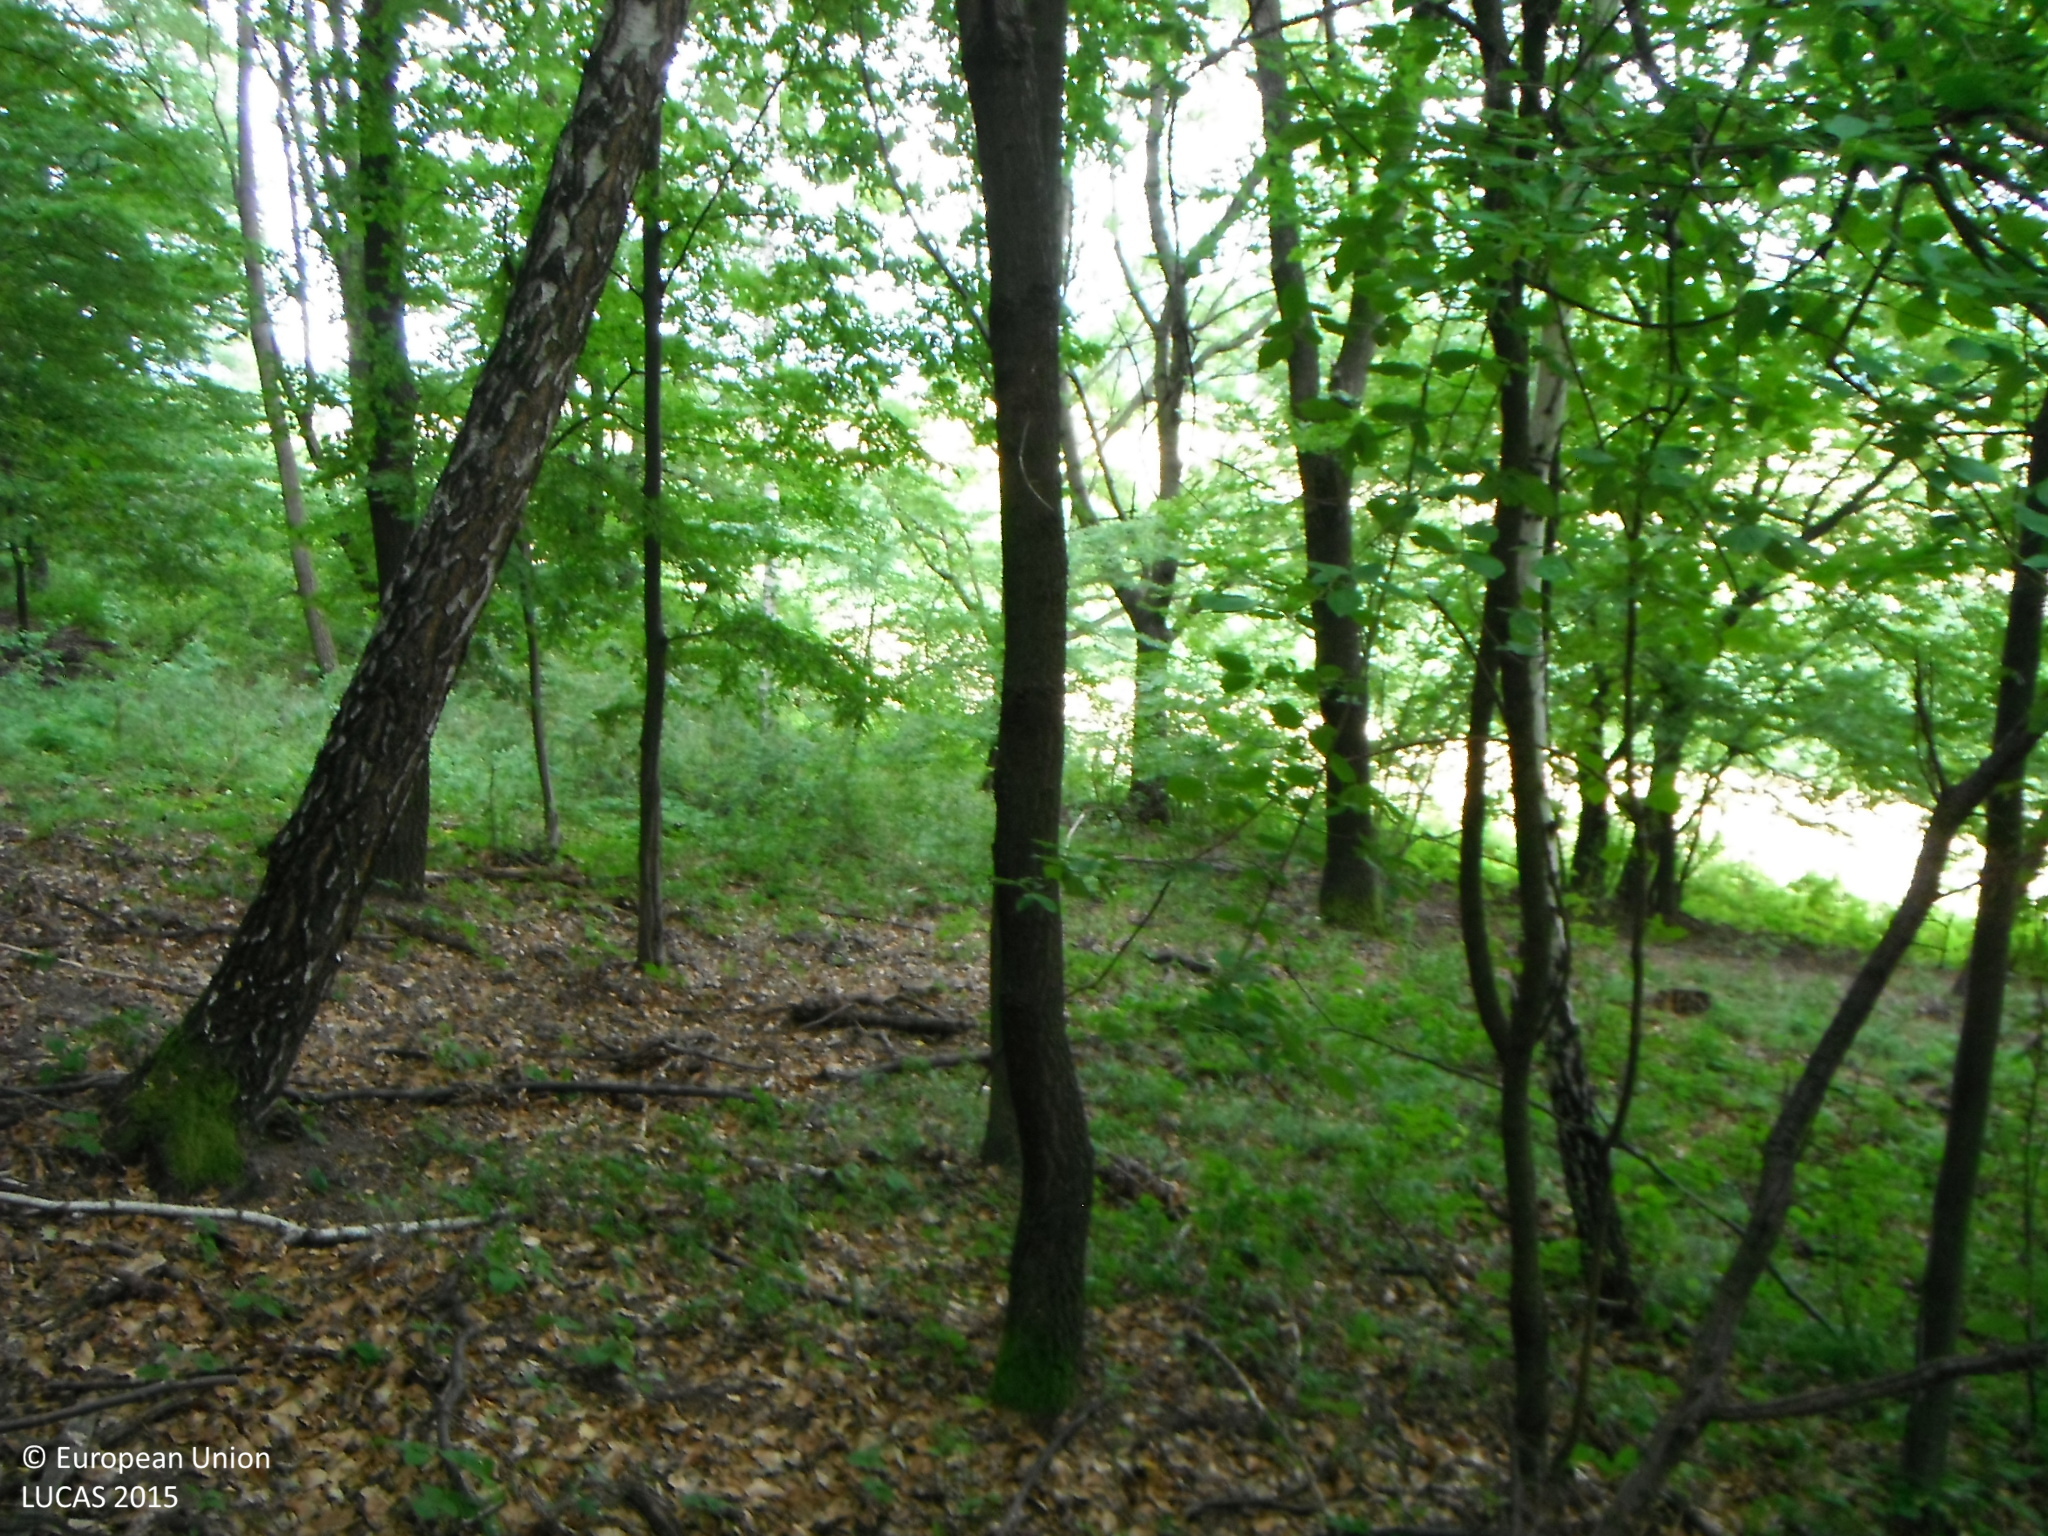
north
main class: Woodland
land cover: Broadleaved woodland
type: mesophytic deciduous forest
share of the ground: > 75 %
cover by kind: broadleaved forest trees 100 %
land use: Forestry
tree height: > 5 m
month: July
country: SK
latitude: 48.3307
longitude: 18.9358
